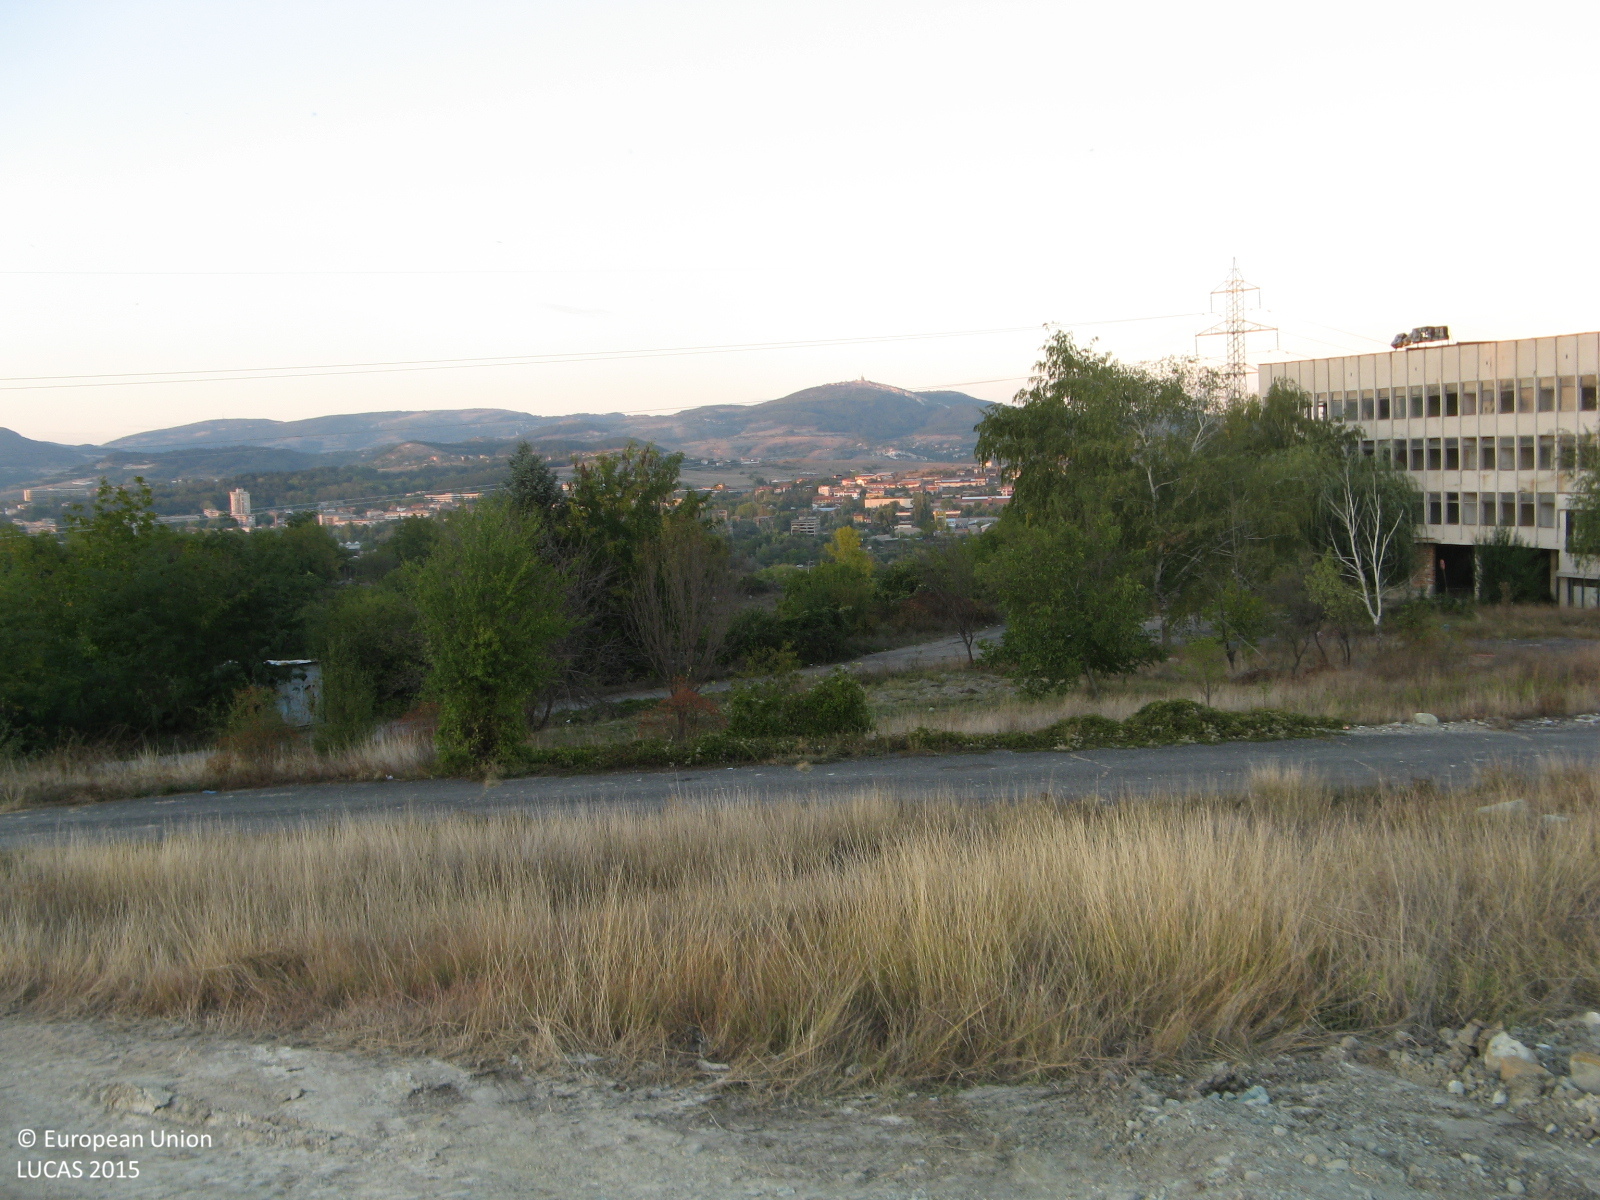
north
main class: Grassland
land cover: Spontaneously vegetated surfaces
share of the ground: > 75 %
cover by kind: herbaceous plants 100 %
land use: Fallow land
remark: Harvested field
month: October
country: BG
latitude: 41.6177
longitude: 25.3823
